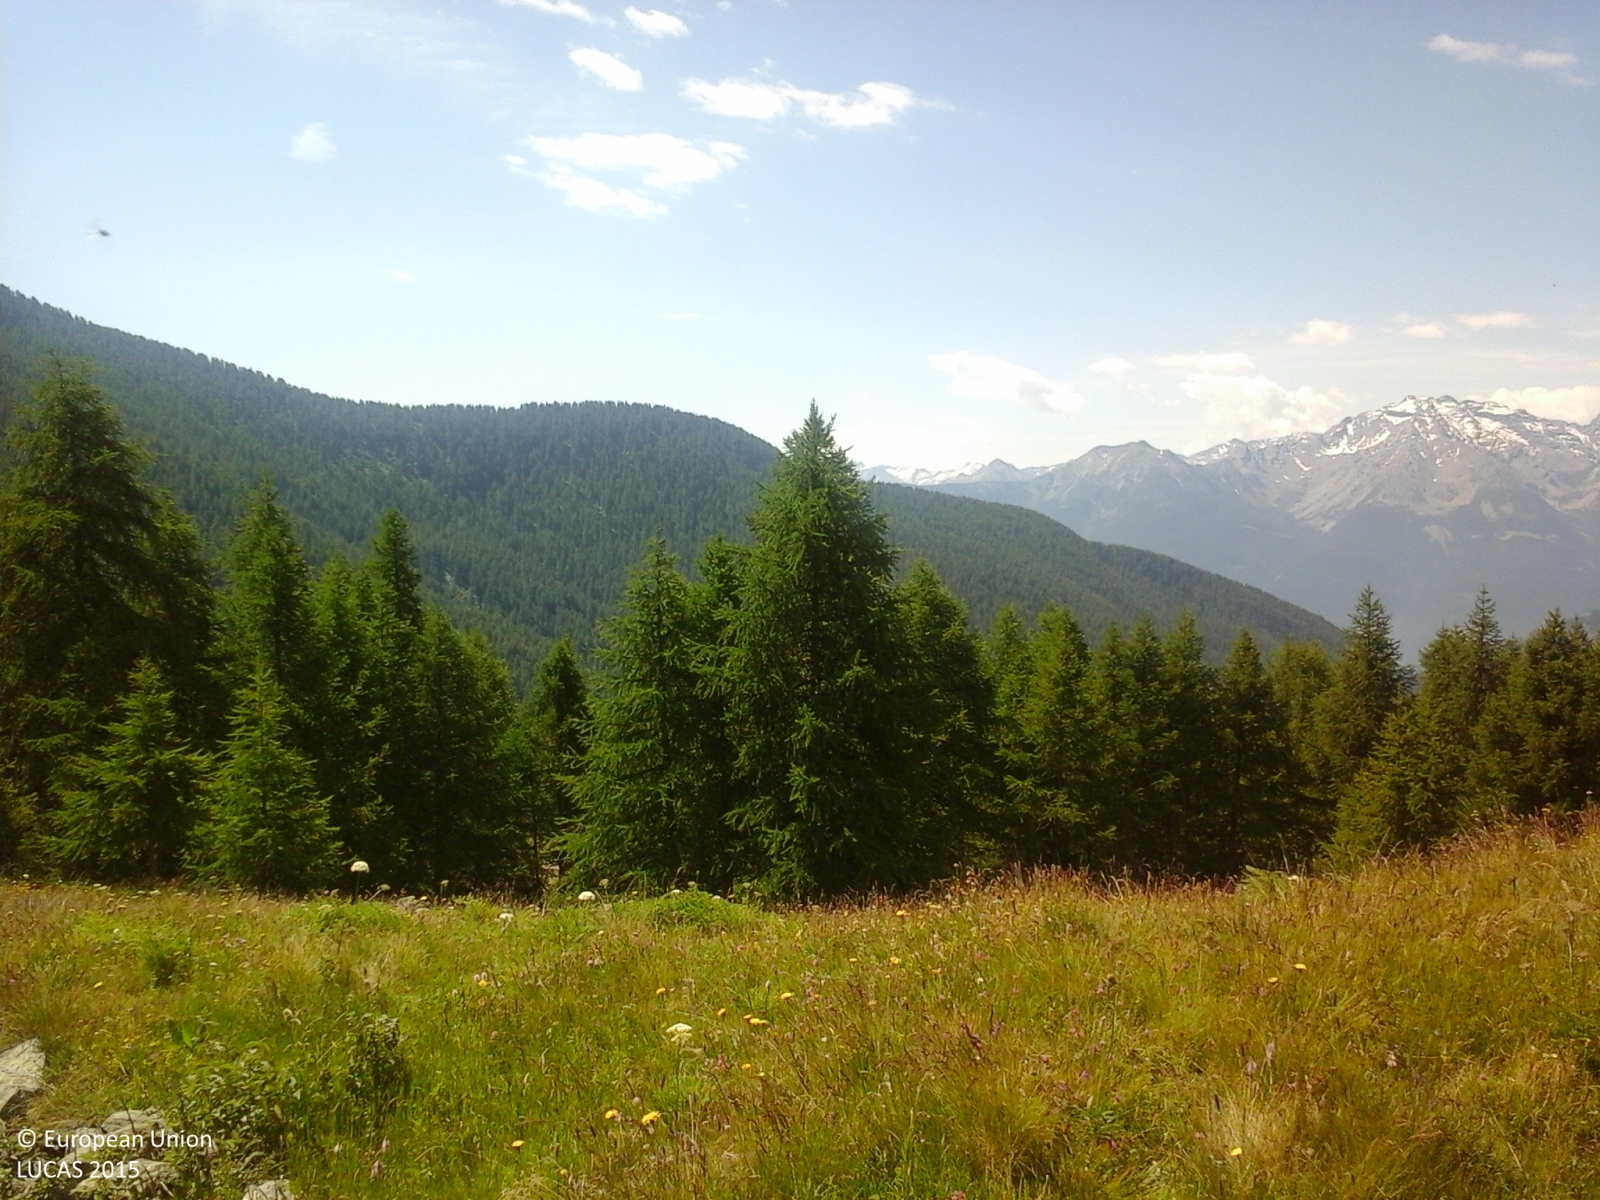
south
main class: Grassland
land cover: Grassland with sparse tree/shrub cover
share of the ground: > 75 %
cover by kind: herbaceous plants 90 %, coniferous forest trees 5 %
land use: Agriculture (excluding fallow land and kitchen gardens)
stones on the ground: < 10 %
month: June
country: IT
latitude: 45.8202
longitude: 7.6222
